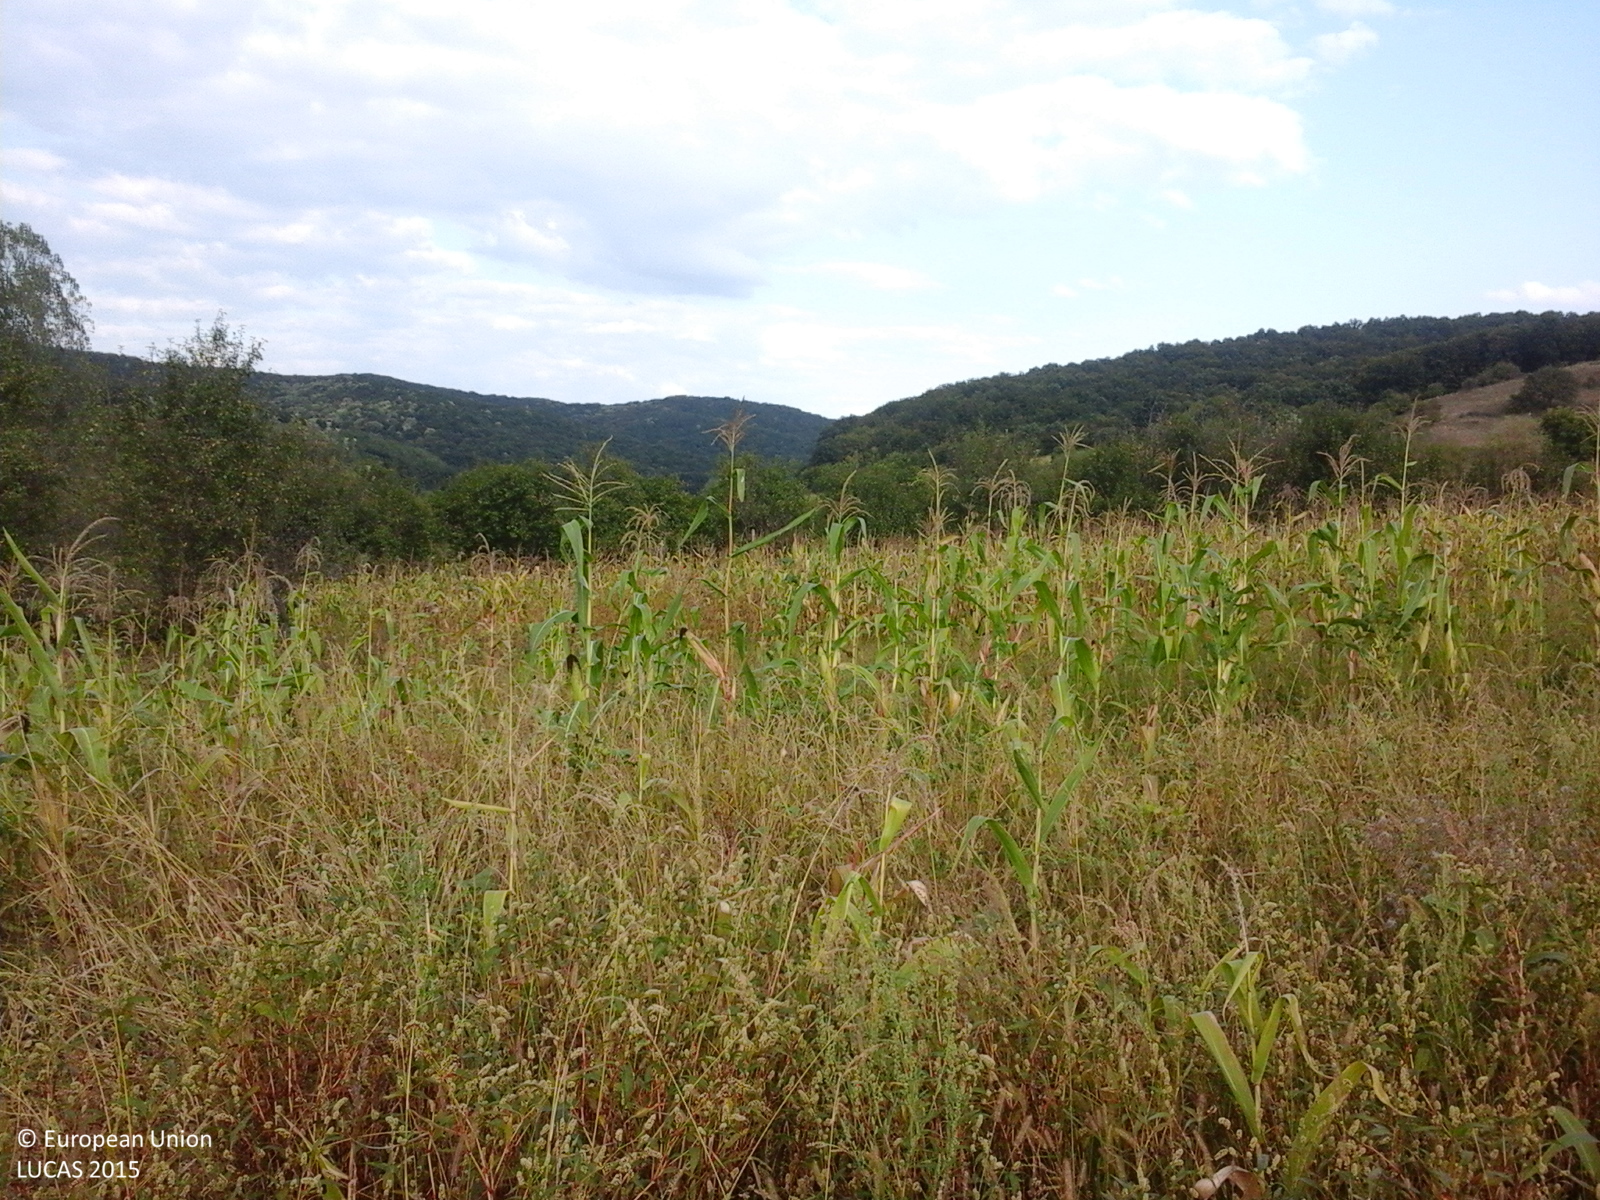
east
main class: Grassland
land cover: Grassland without tree/shrub cover
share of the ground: > 75 %
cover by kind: herbaceous plants 100 %
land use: Agriculture (excluding fallow land and kitchen gardens)
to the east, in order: Grassland without tree/shrub cover; Maize; Other fruit trees and berries; Maize; Grassland without tree/shrub cover; Abandoned hedges; Lucerne; Maize
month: September
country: RO
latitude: 47.2980
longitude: 23.1994
